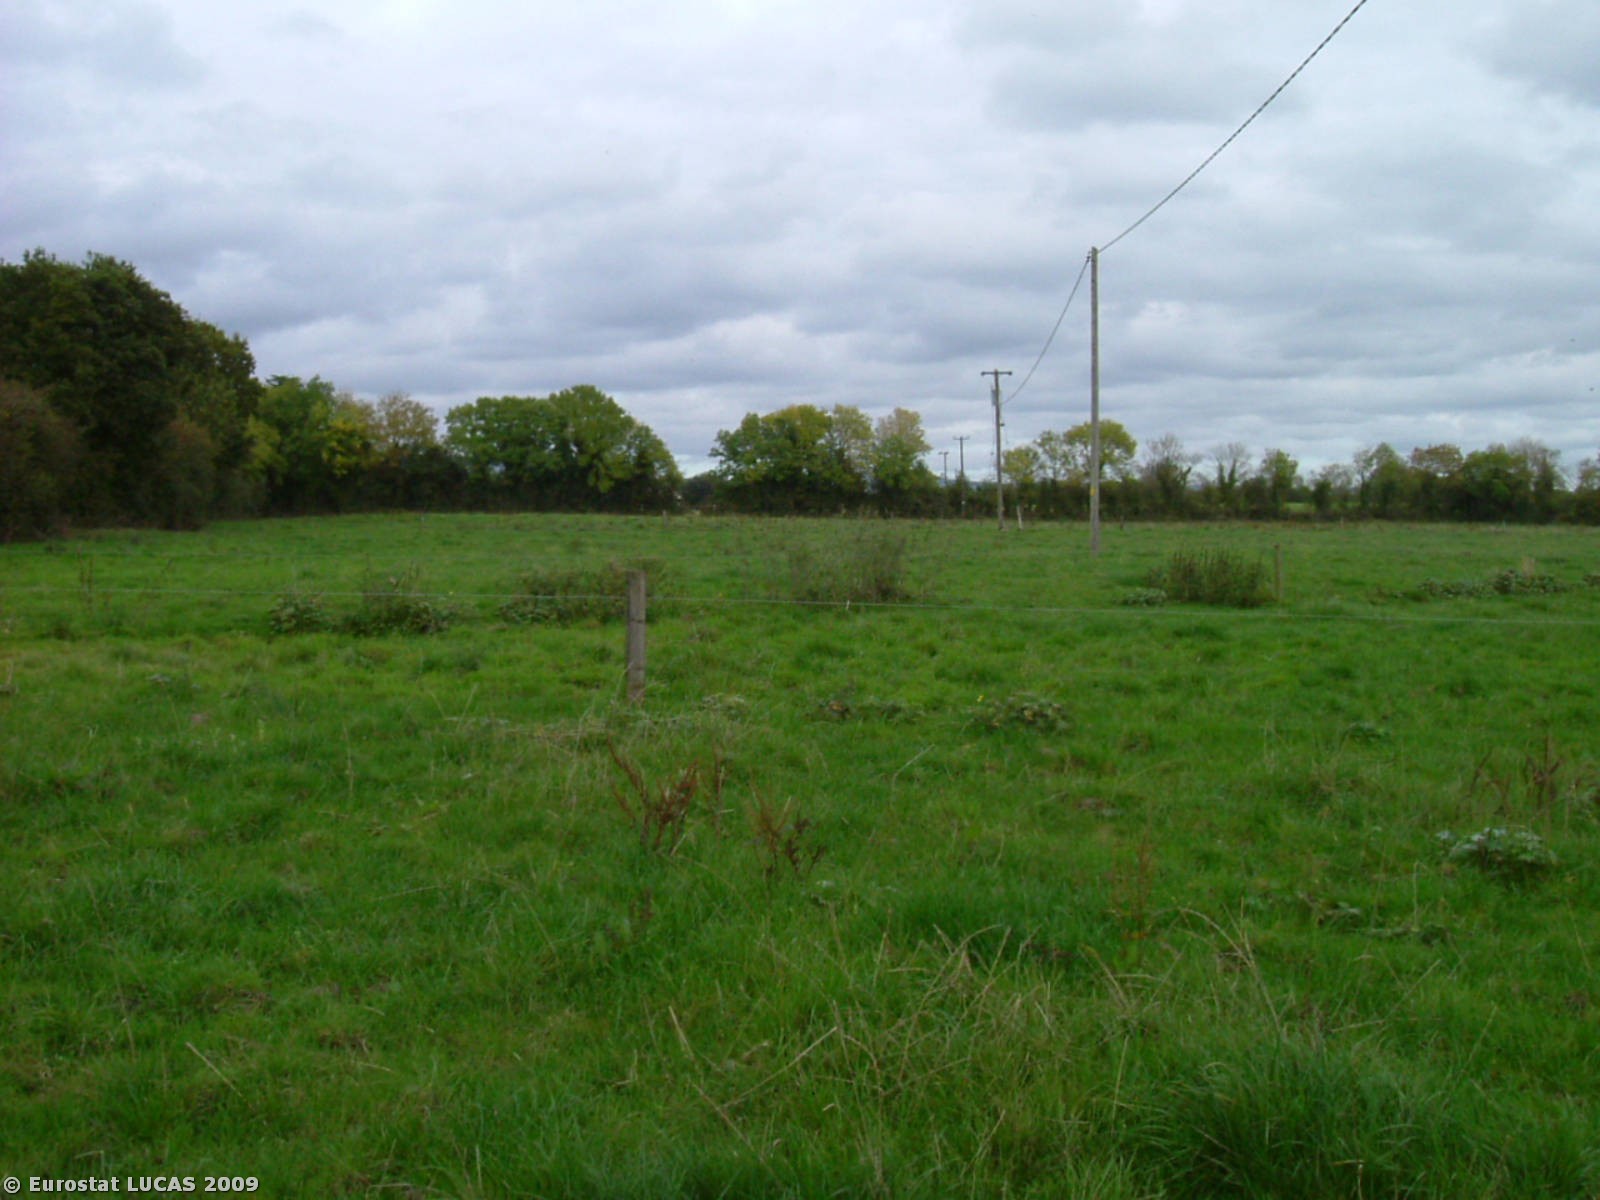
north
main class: Grassland
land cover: Grassland without tree/shrub cover
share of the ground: > 75 %
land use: Agriculture (excluding fallow land and kitchen gardens)
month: October
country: IE
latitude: 52.5380
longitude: -8.2149
